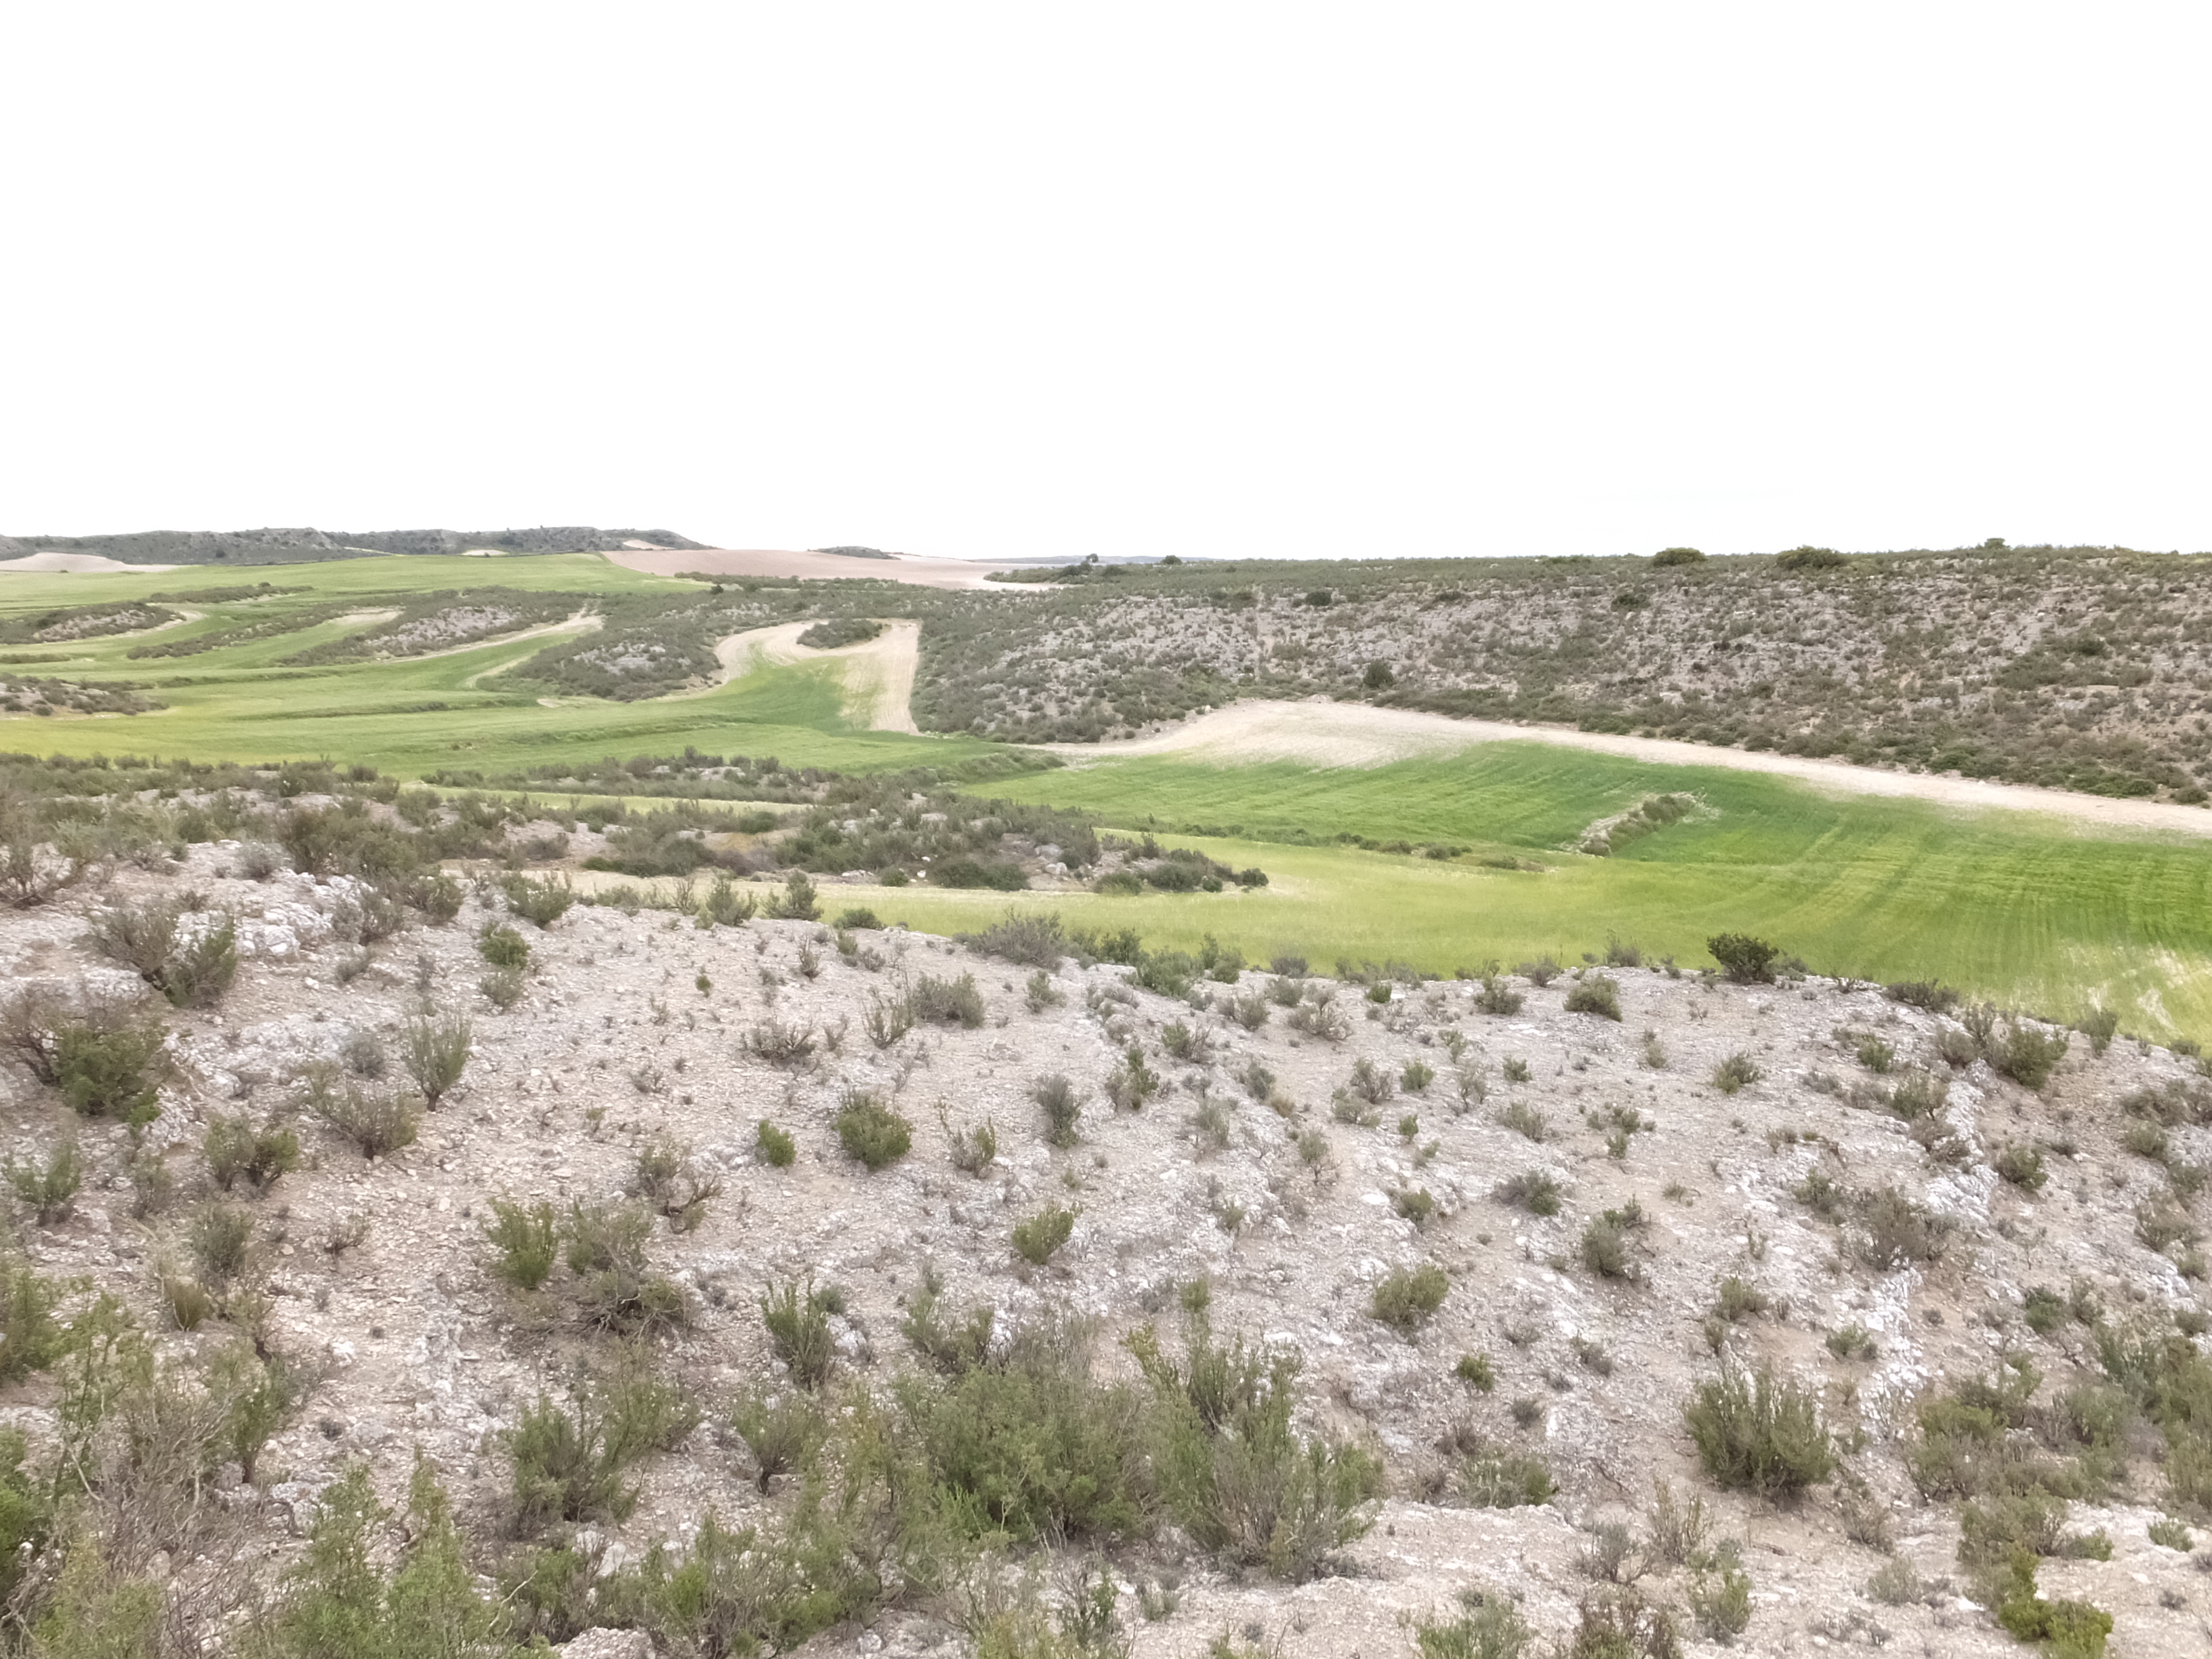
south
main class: Shrubland
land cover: Shrubland without tree cover
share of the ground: 25 - 50 %
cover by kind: shrubs 40 %, consolidated bare surface 35 %, herbaceous plants 25 %
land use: Semi-natural and natural areas not in use
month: May
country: ES
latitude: 41.4852
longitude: -0.3525
